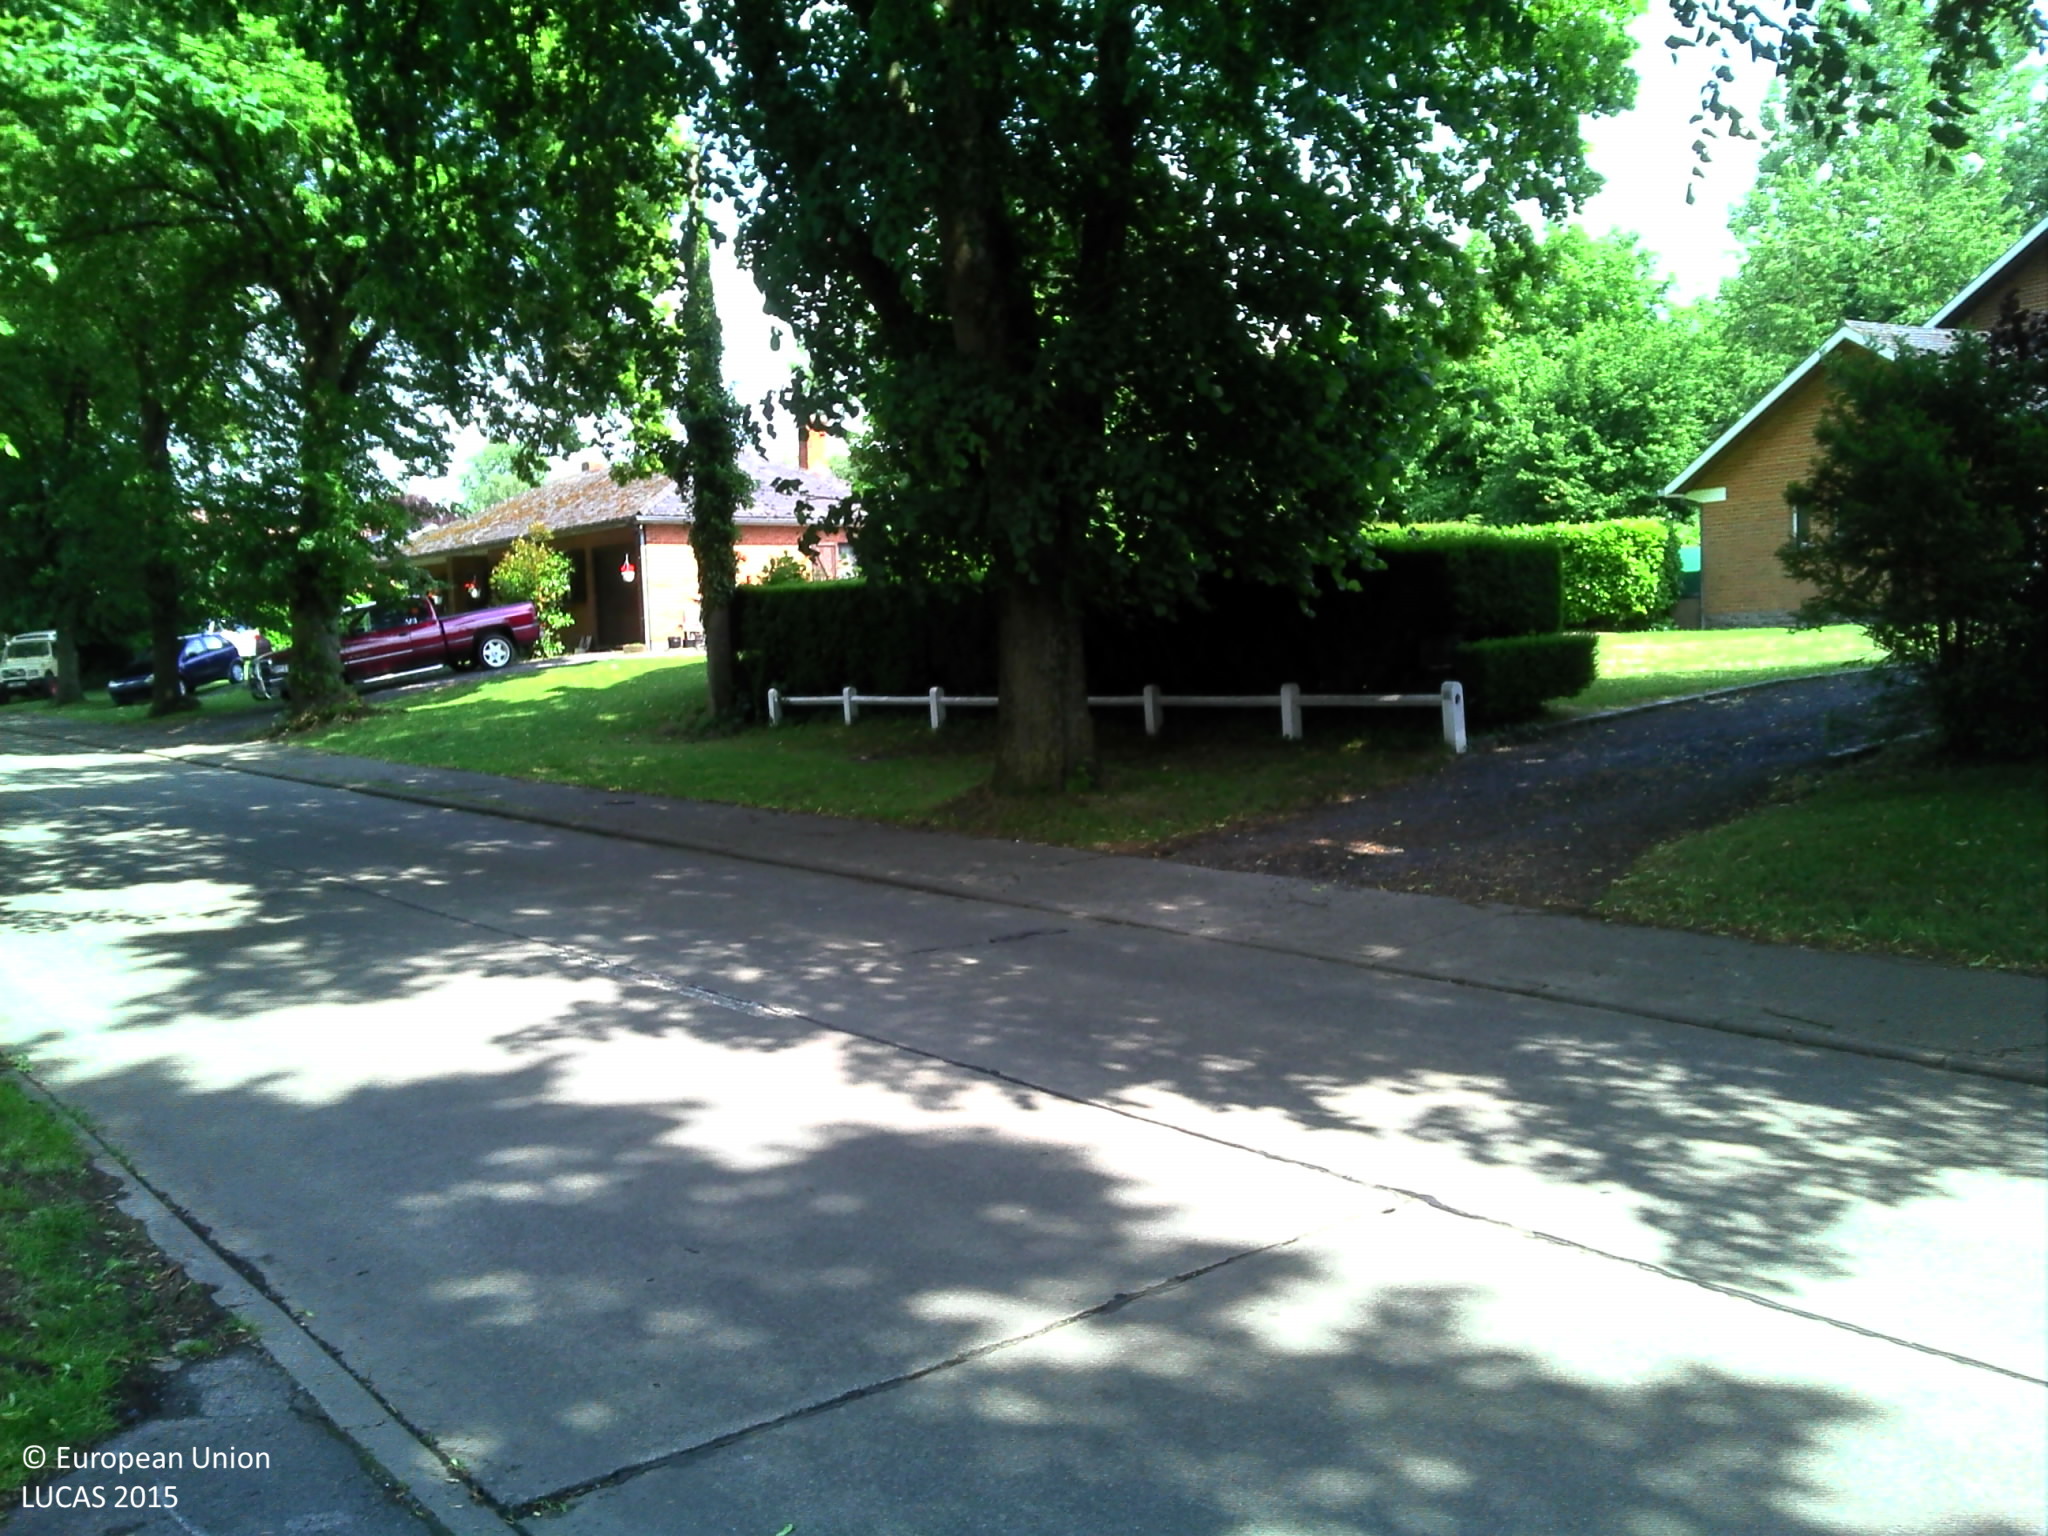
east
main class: Grassland
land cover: Grassland with sparse tree/shrub cover
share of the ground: 50 - 75 %
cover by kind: herbaceous plants 95 %, broadleaved forest trees 5 %
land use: Residential
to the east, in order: Grassland with sparse tree/shrub cover; Lines of trees; Paved roads, cycling and walking lanes; Lines of trees; Artificial constructions in urban areas; Broadleaved woodland
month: June
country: BE
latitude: 50.3564
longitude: 3.7668
